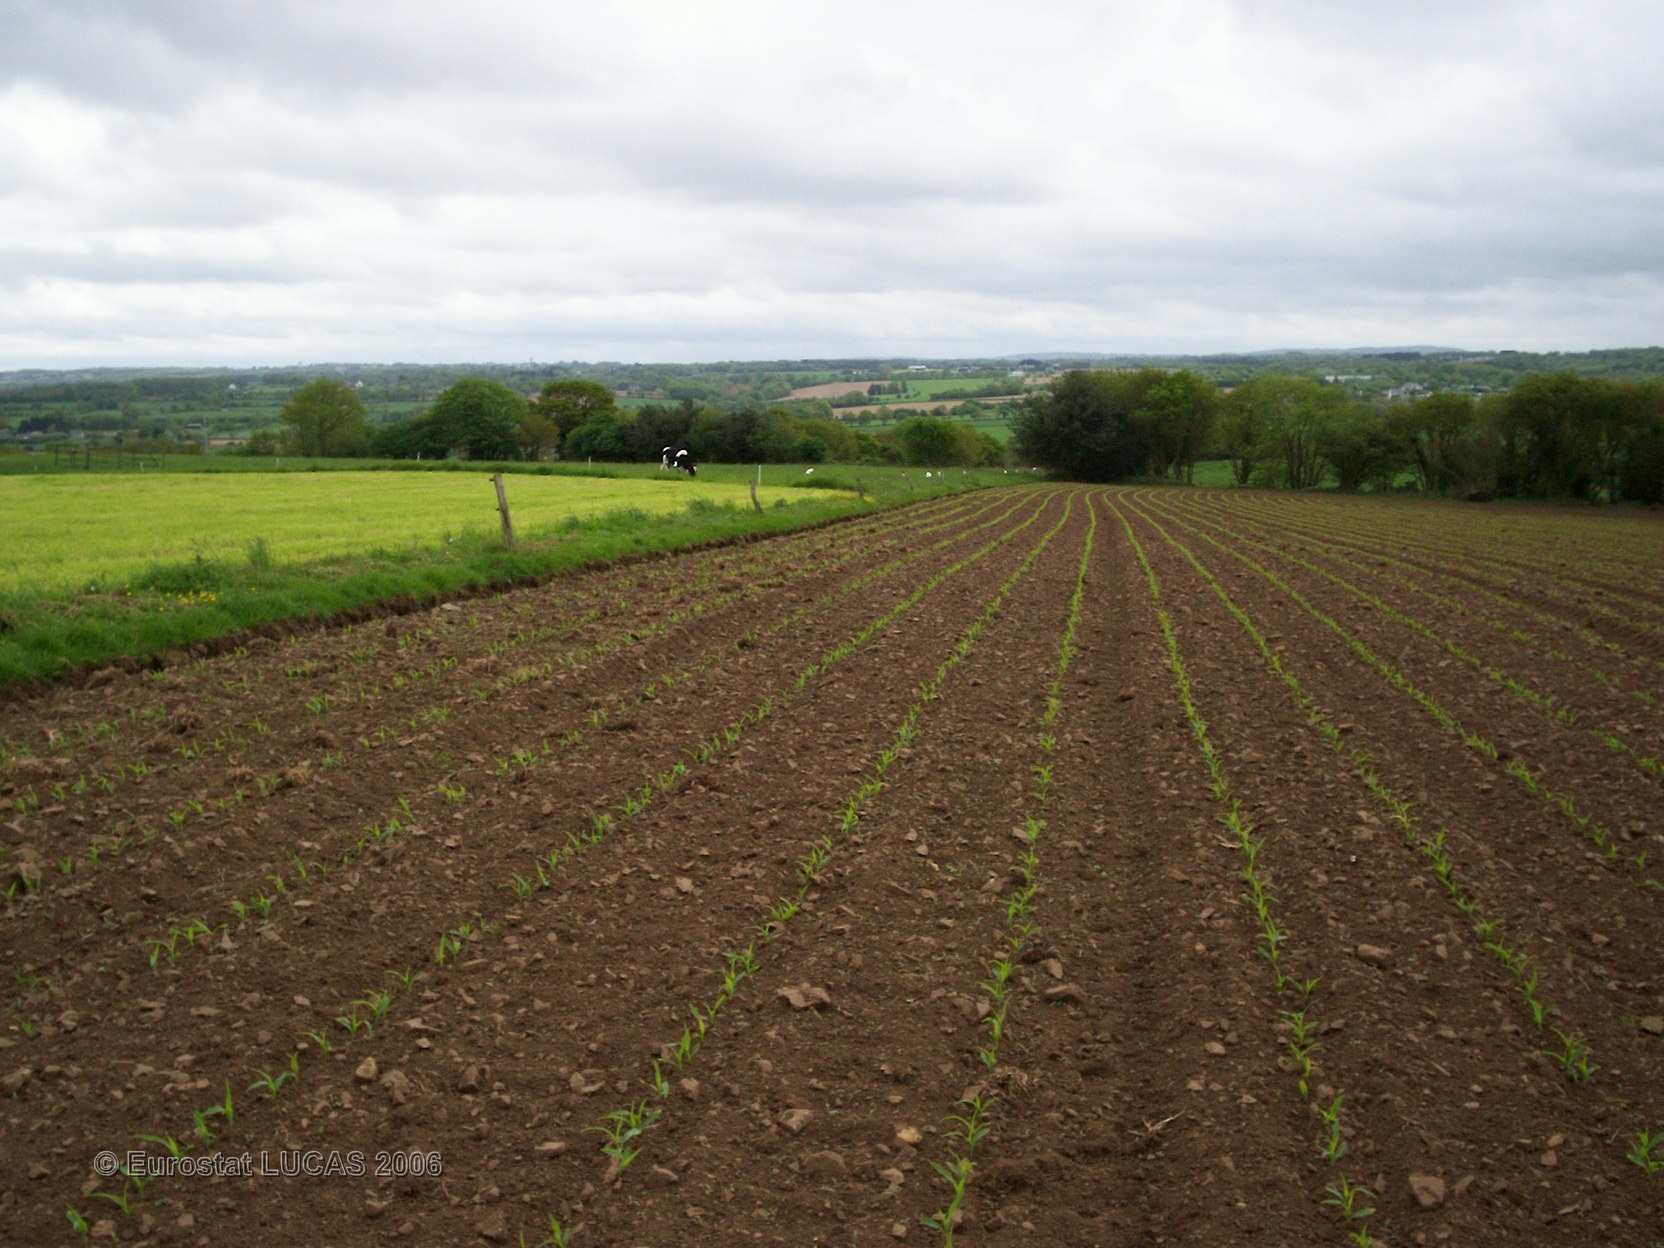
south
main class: Cropland
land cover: Maize
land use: Agriculture (excluding fallow land and kitchen gardens)
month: May
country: FR
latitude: 48.6168
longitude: -3.7440
